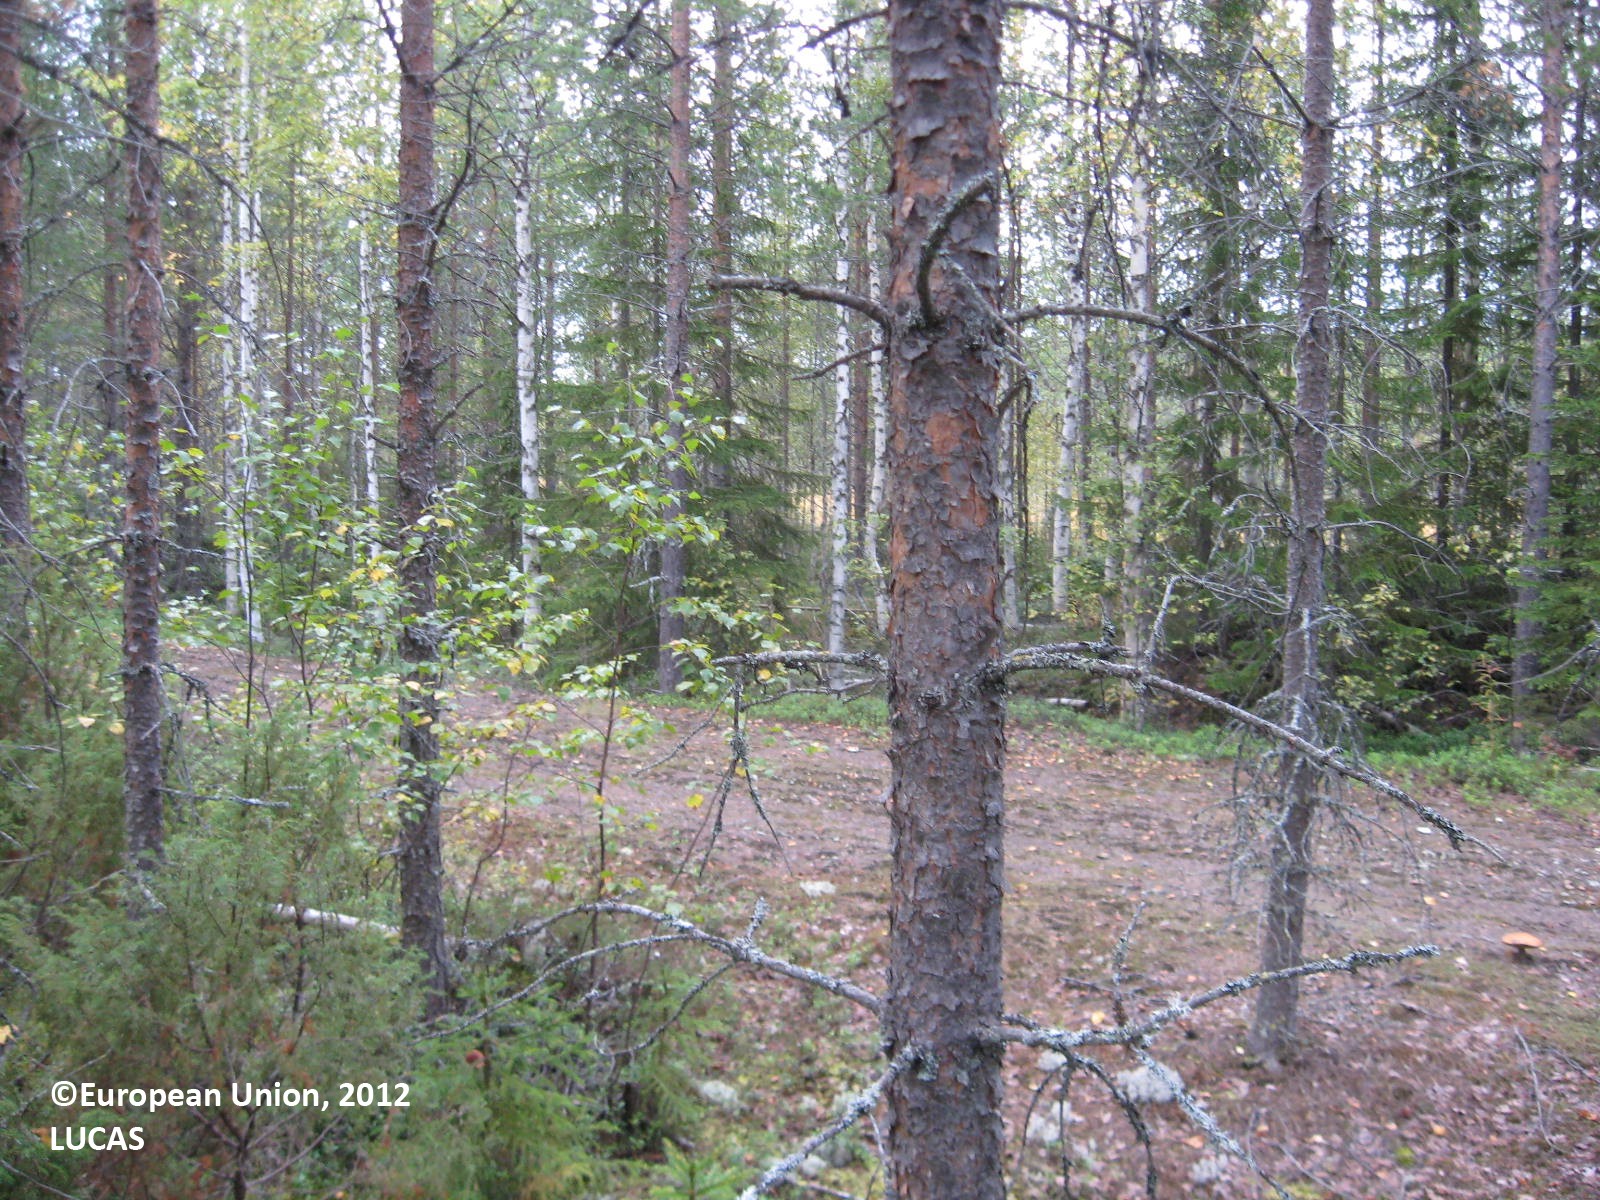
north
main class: Woodland
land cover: Pine dominated coniferous woodland
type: boreal forest
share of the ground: > 75 %
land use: Forestry
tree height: > 5 m
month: August
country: FI
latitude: 63.7536
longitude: 29.7518
